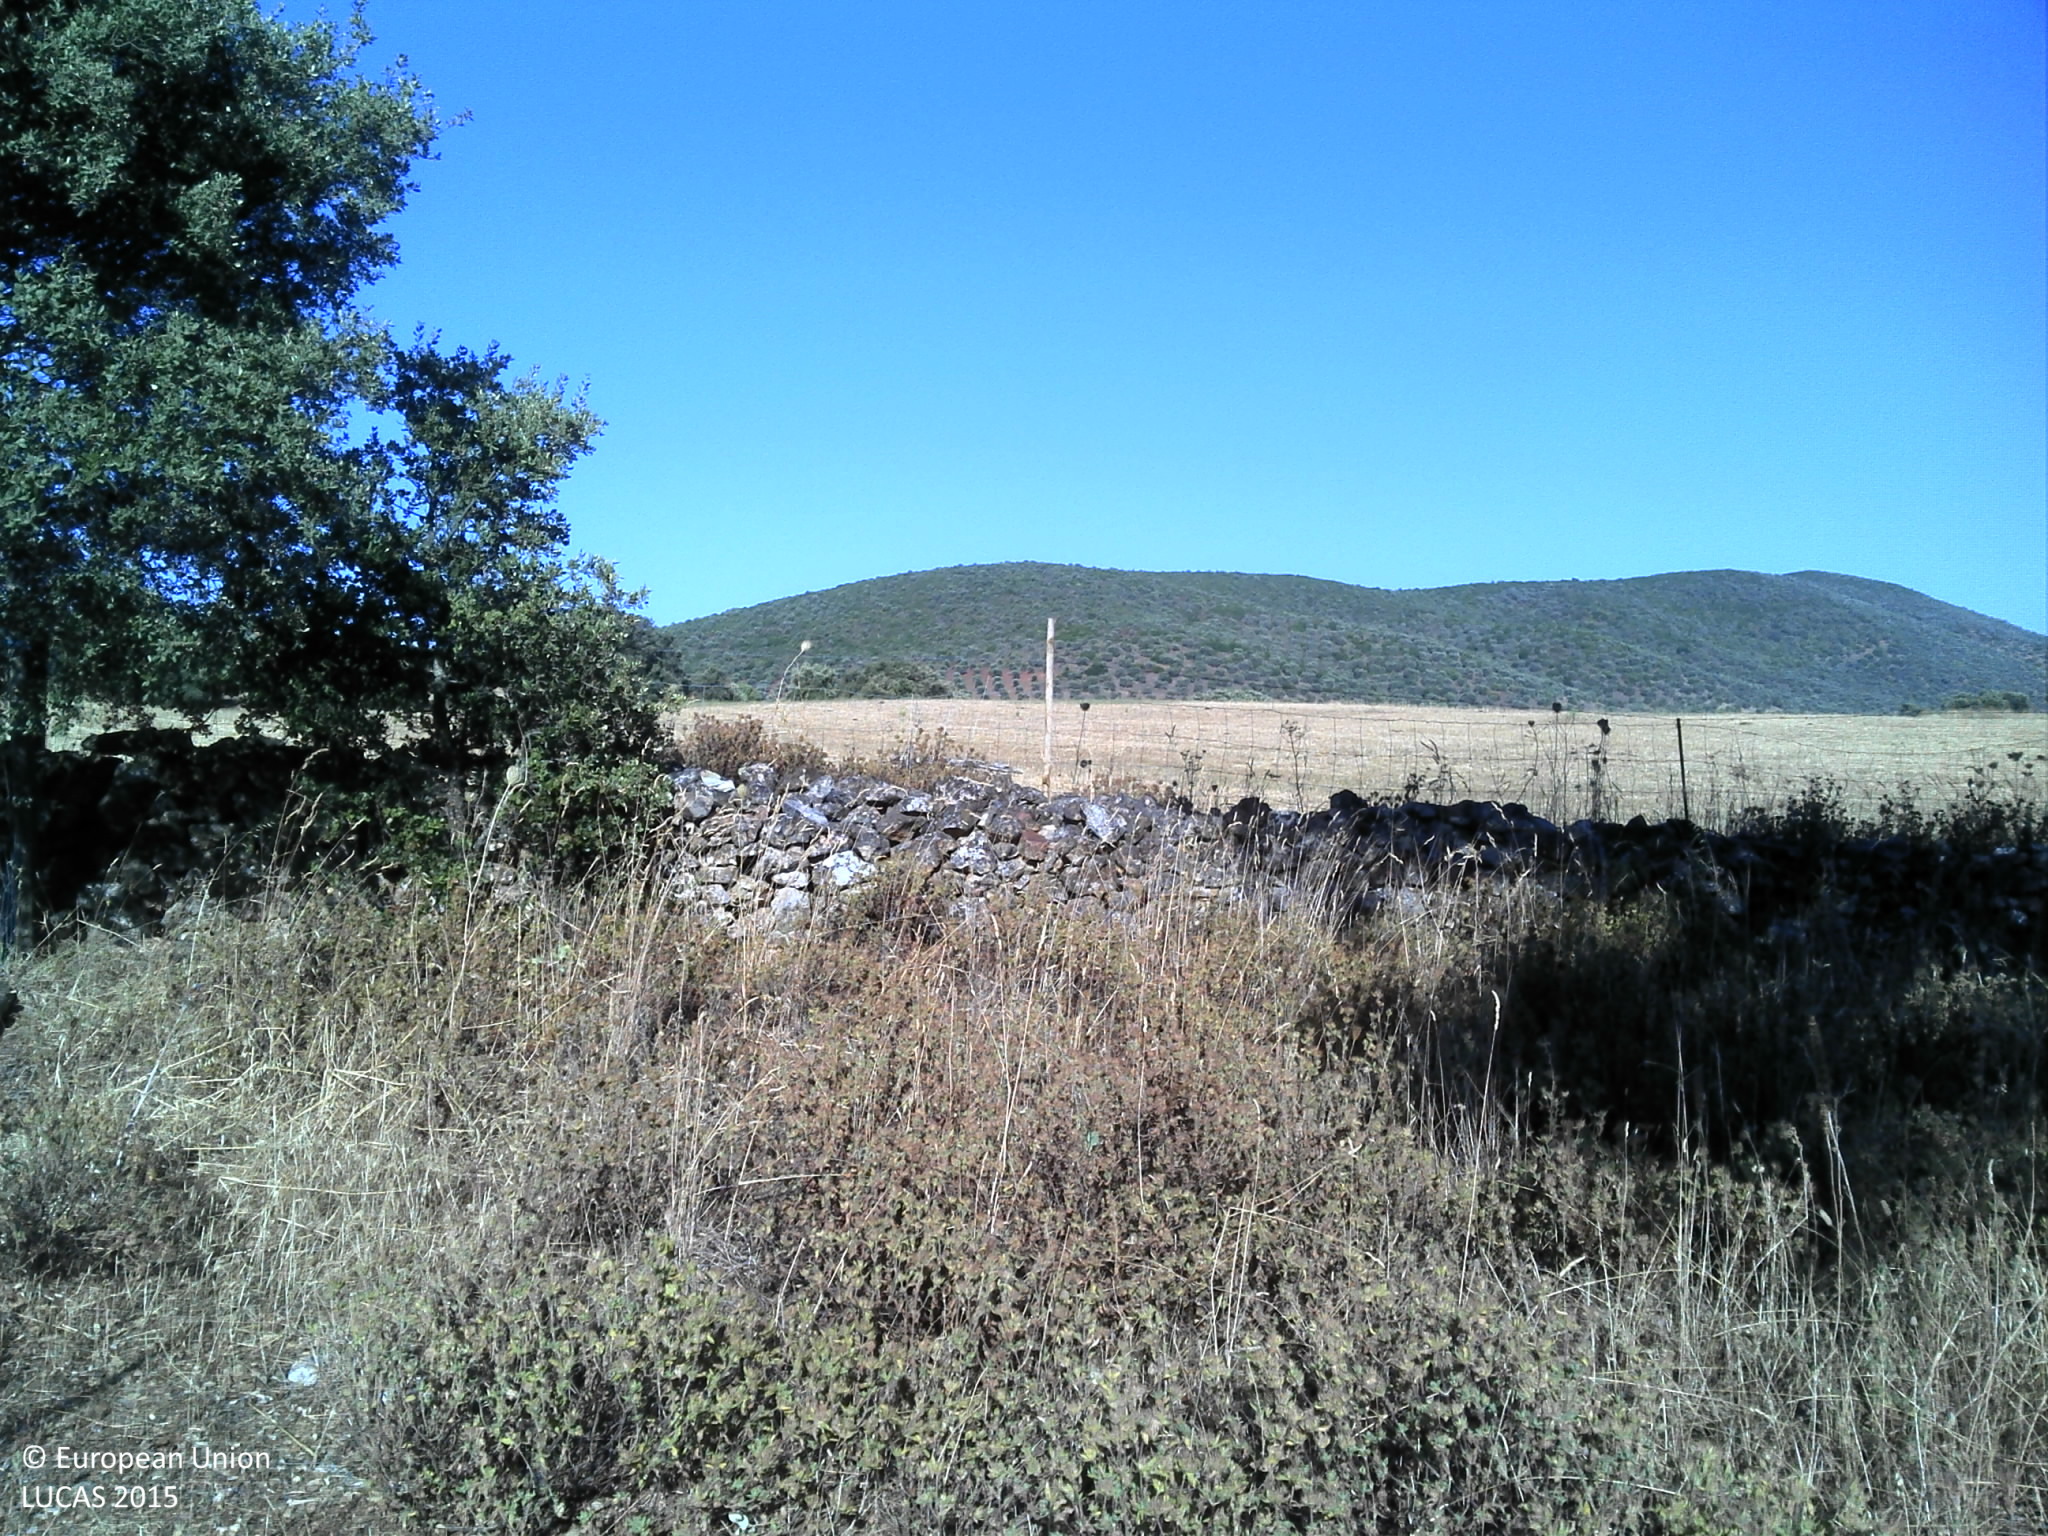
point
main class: Grassland
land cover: Grassland without tree/shrub cover
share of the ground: > 75 %
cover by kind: herbaceous plants 100 %
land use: Agriculture (excluding fallow land and kitchen gardens)
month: June
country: PT
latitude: 37.9773
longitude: -7.3075
